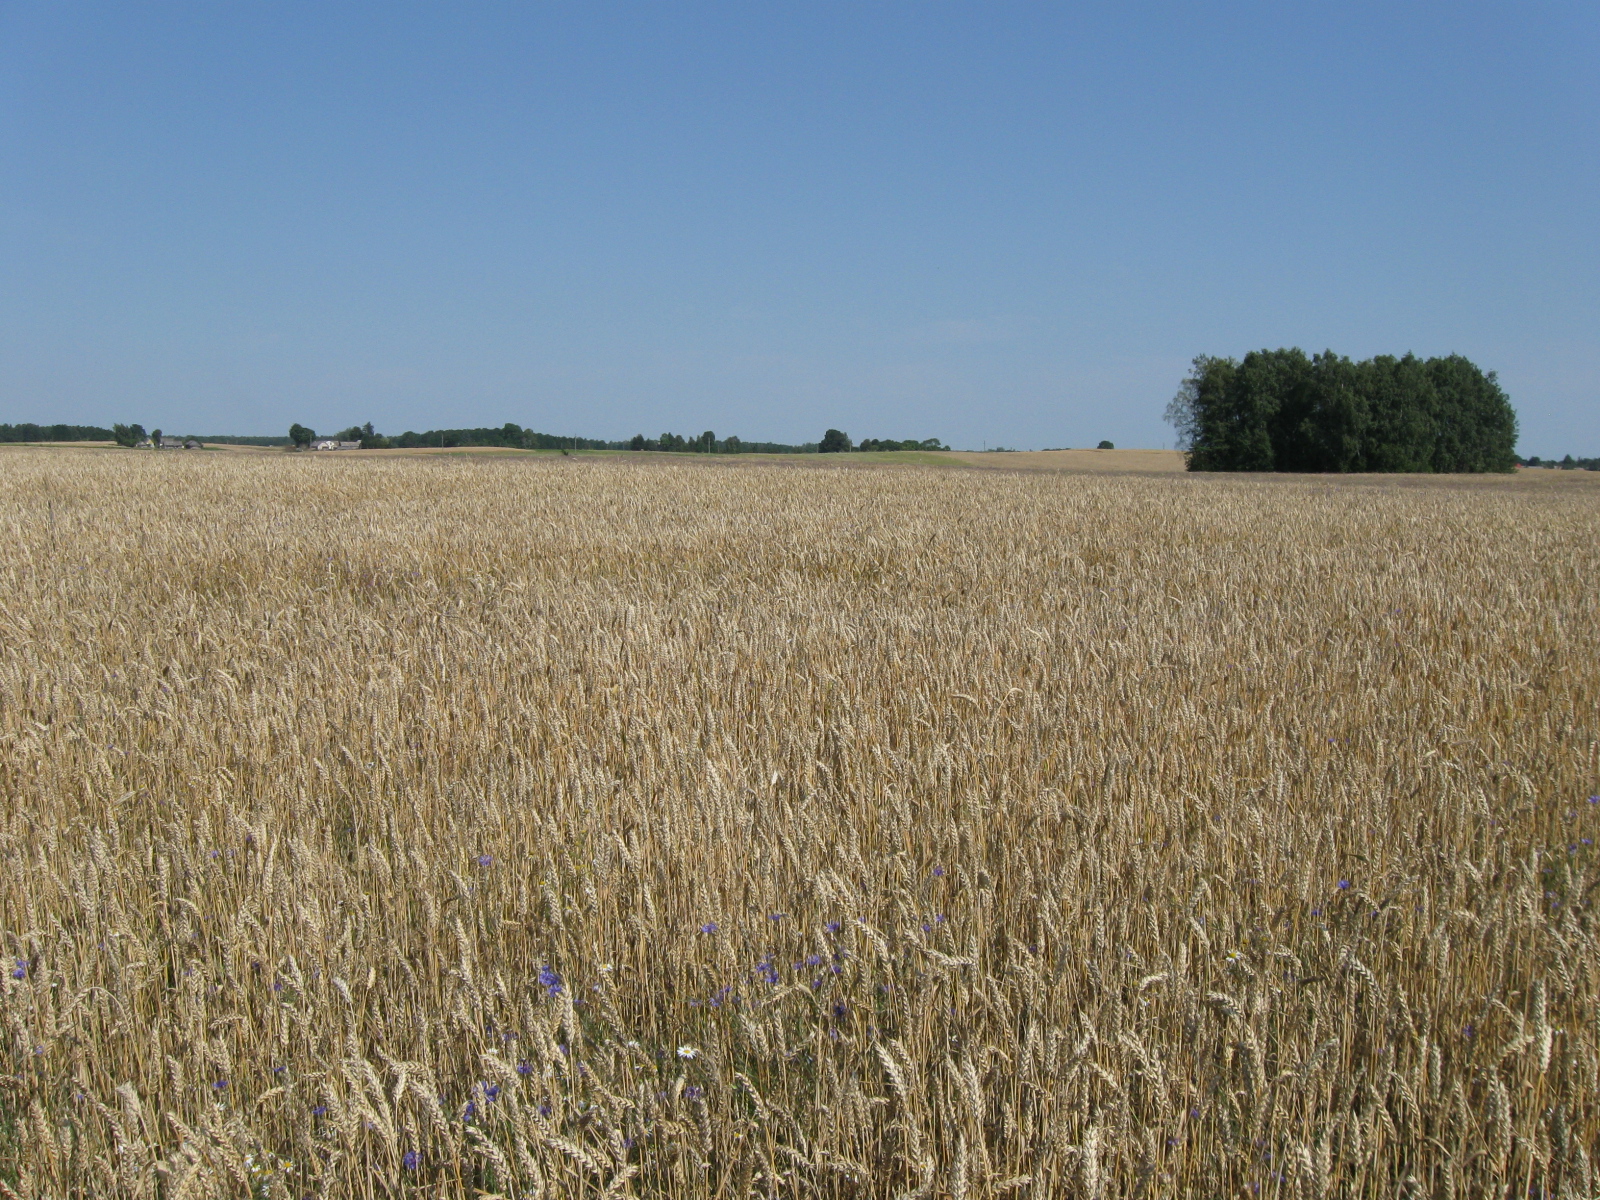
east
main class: Cropland
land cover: Common wheat
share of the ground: > 75 %
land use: Agriculture (excluding fallow land and kitchen gardens)
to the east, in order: Common wheat; Spontaneously vegetated surfaces
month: July
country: LT
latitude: 54.5802
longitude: 23.6219
